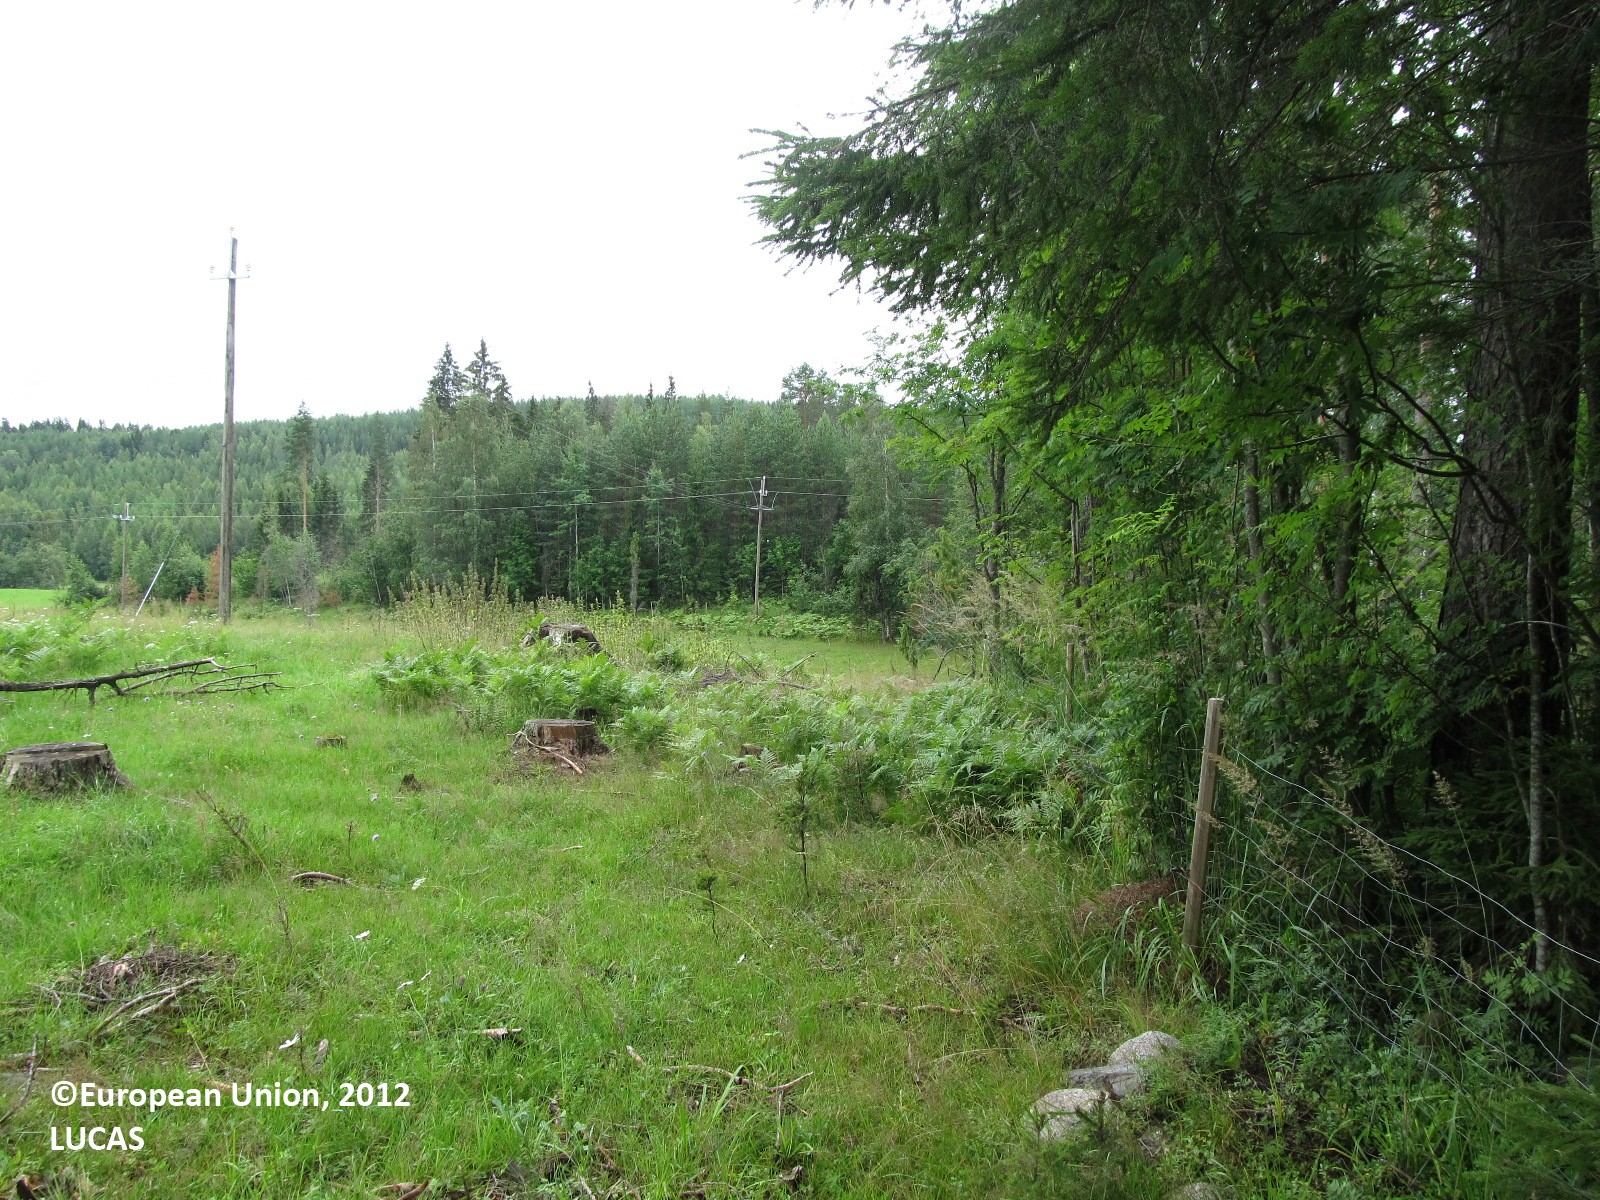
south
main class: Grassland
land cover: Grassland without tree/shrub cover
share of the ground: 25 - 50 %
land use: Forestry
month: July
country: FI
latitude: 61.8472
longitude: 29.0175
